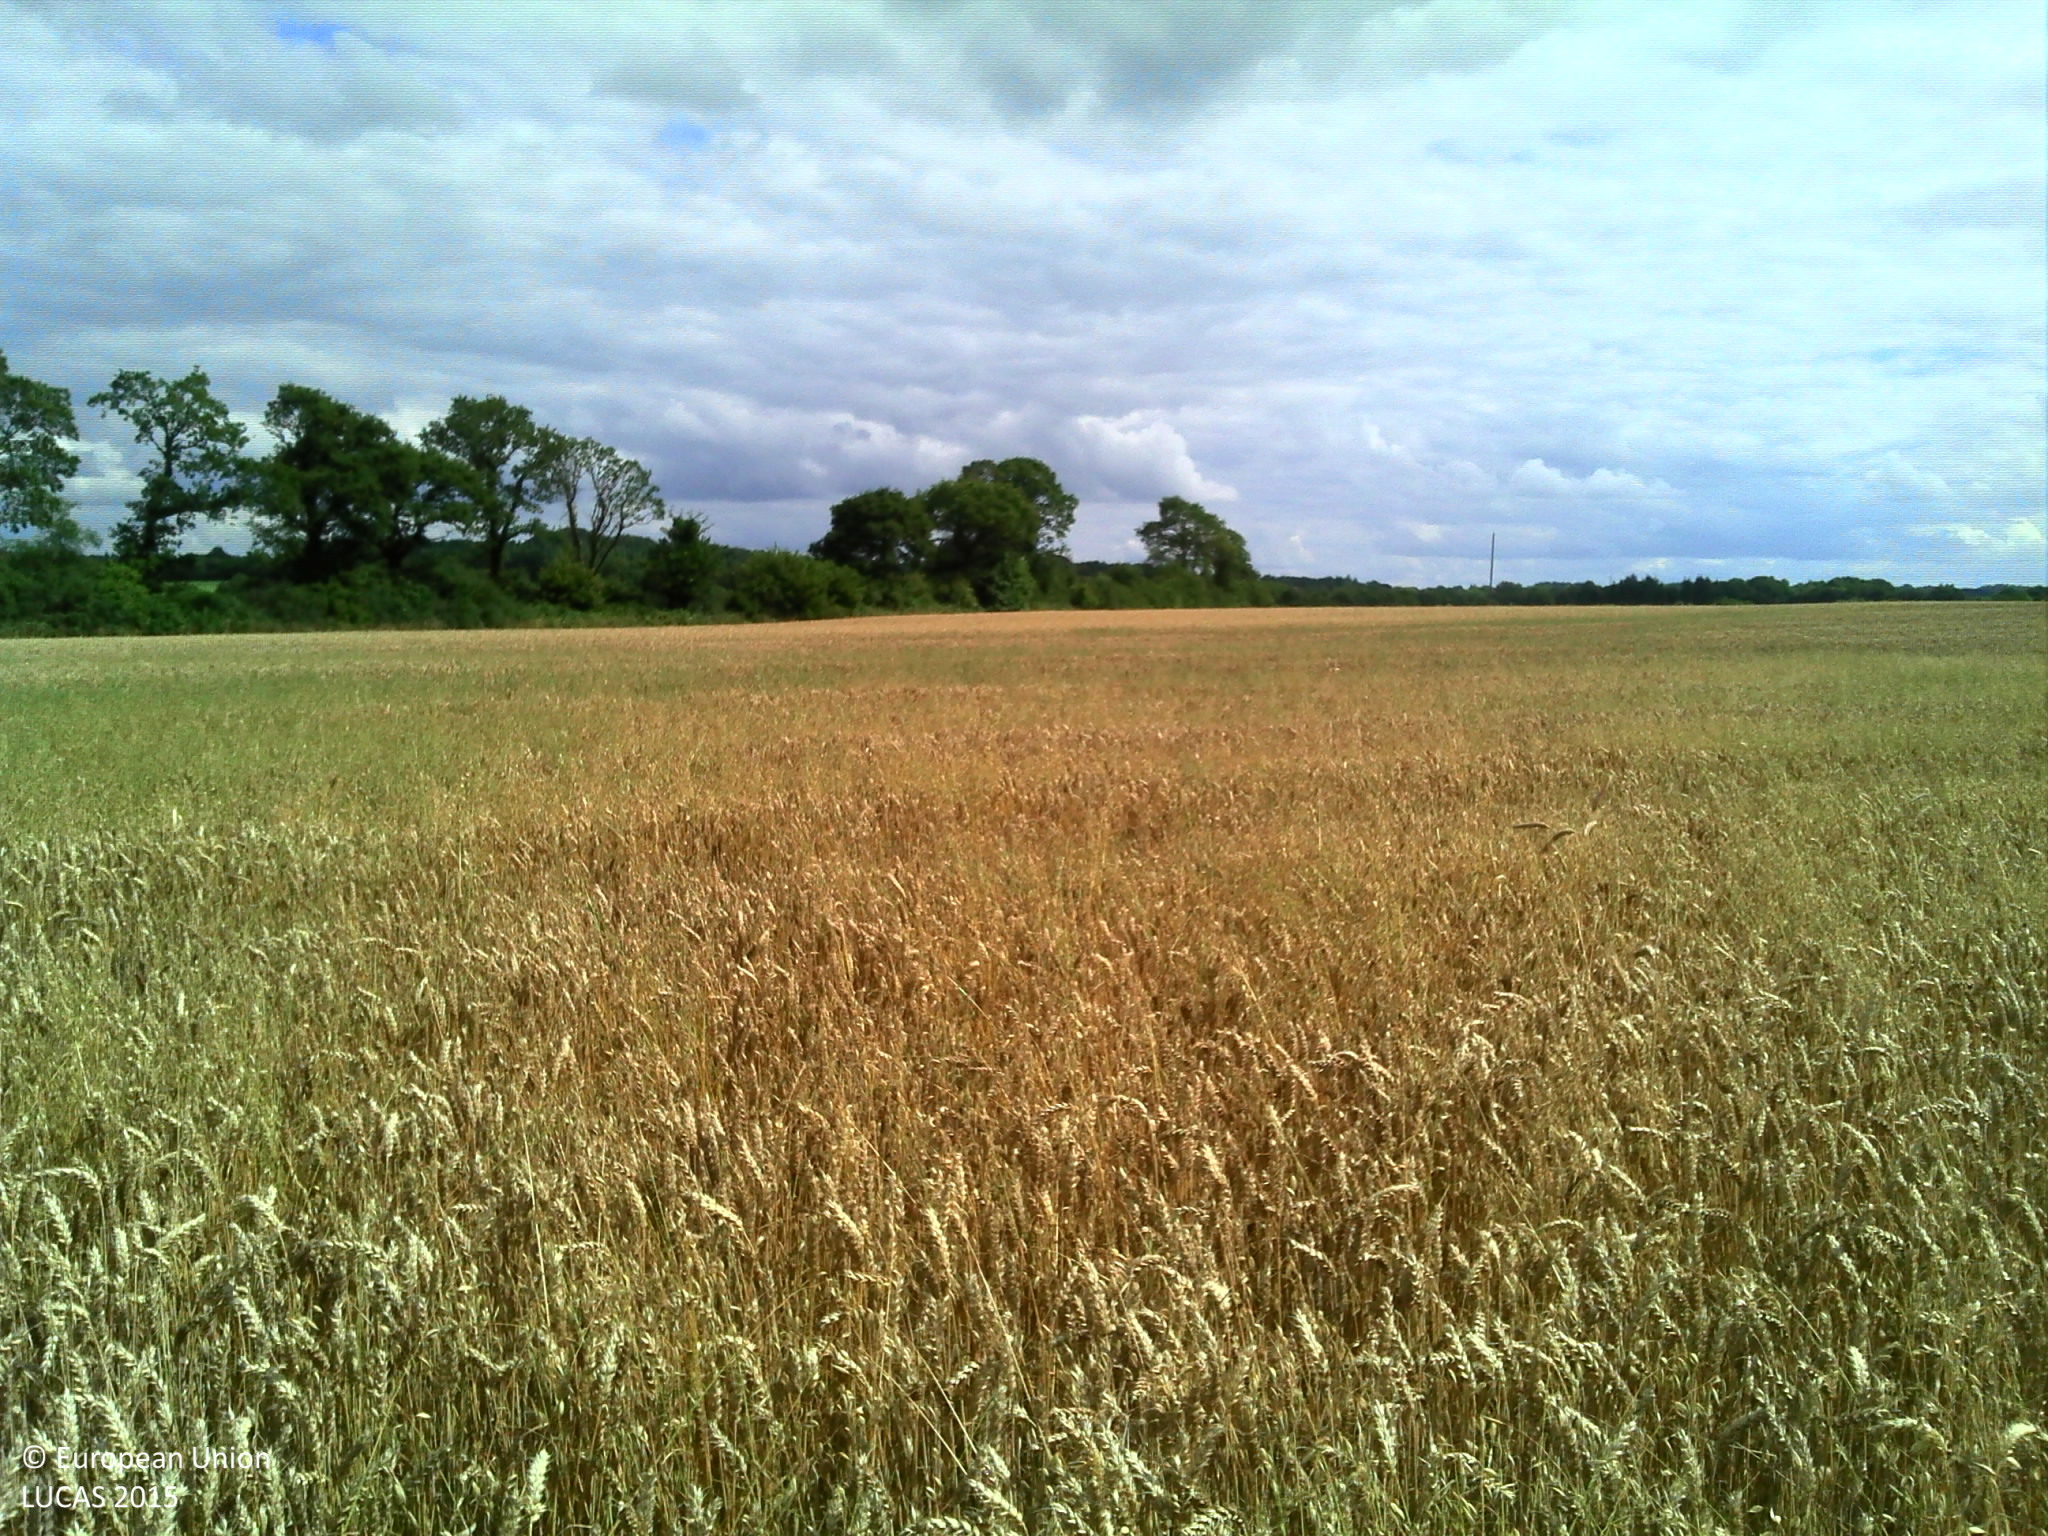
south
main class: Grassland
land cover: Grassland without tree/shrub cover
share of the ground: > 75 %
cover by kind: herbaceous plants 100 %
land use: Agriculture (excluding fallow land and kitchen gardens)
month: July
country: FR
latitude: 48.1701
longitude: -3.3740
